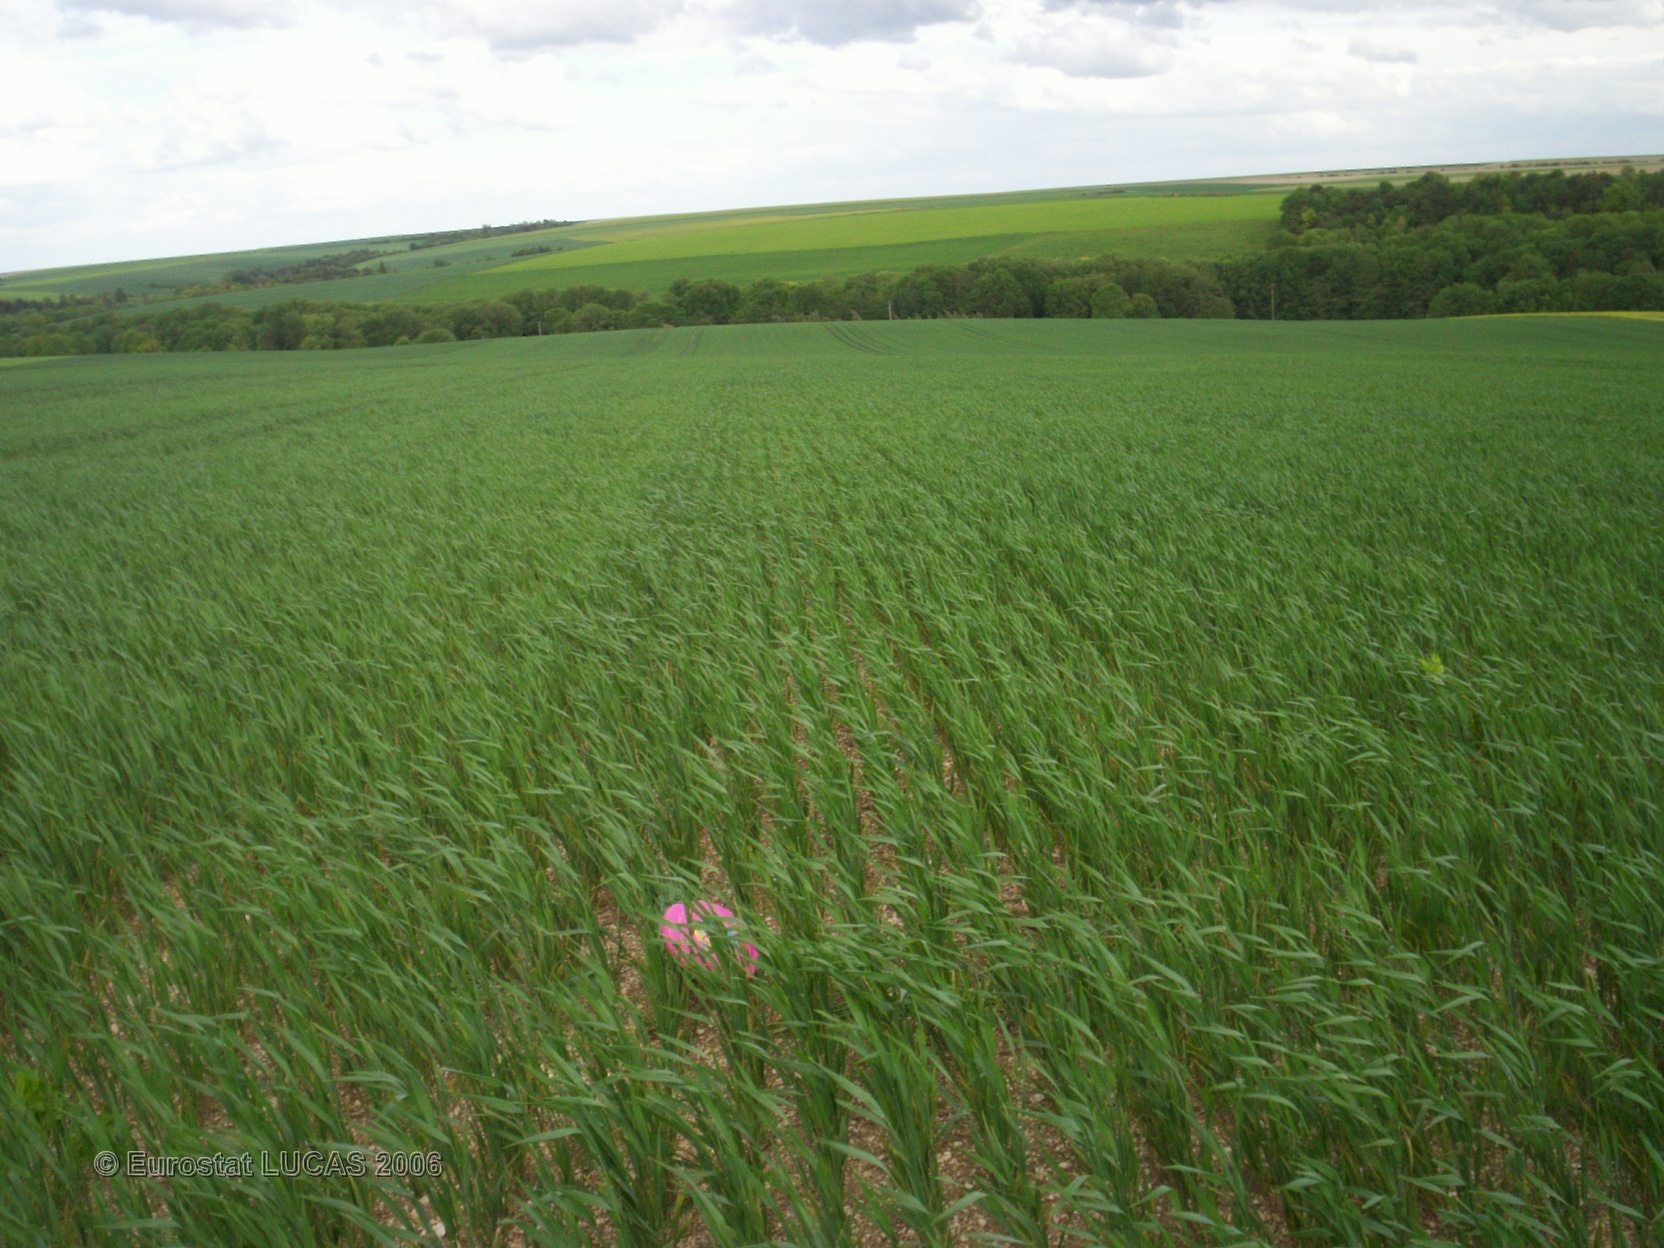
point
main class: Cropland
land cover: Common wheat
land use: Agriculture (excluding fallow land and kitchen gardens)
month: May
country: FR
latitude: 49.3527
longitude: 4.5863
